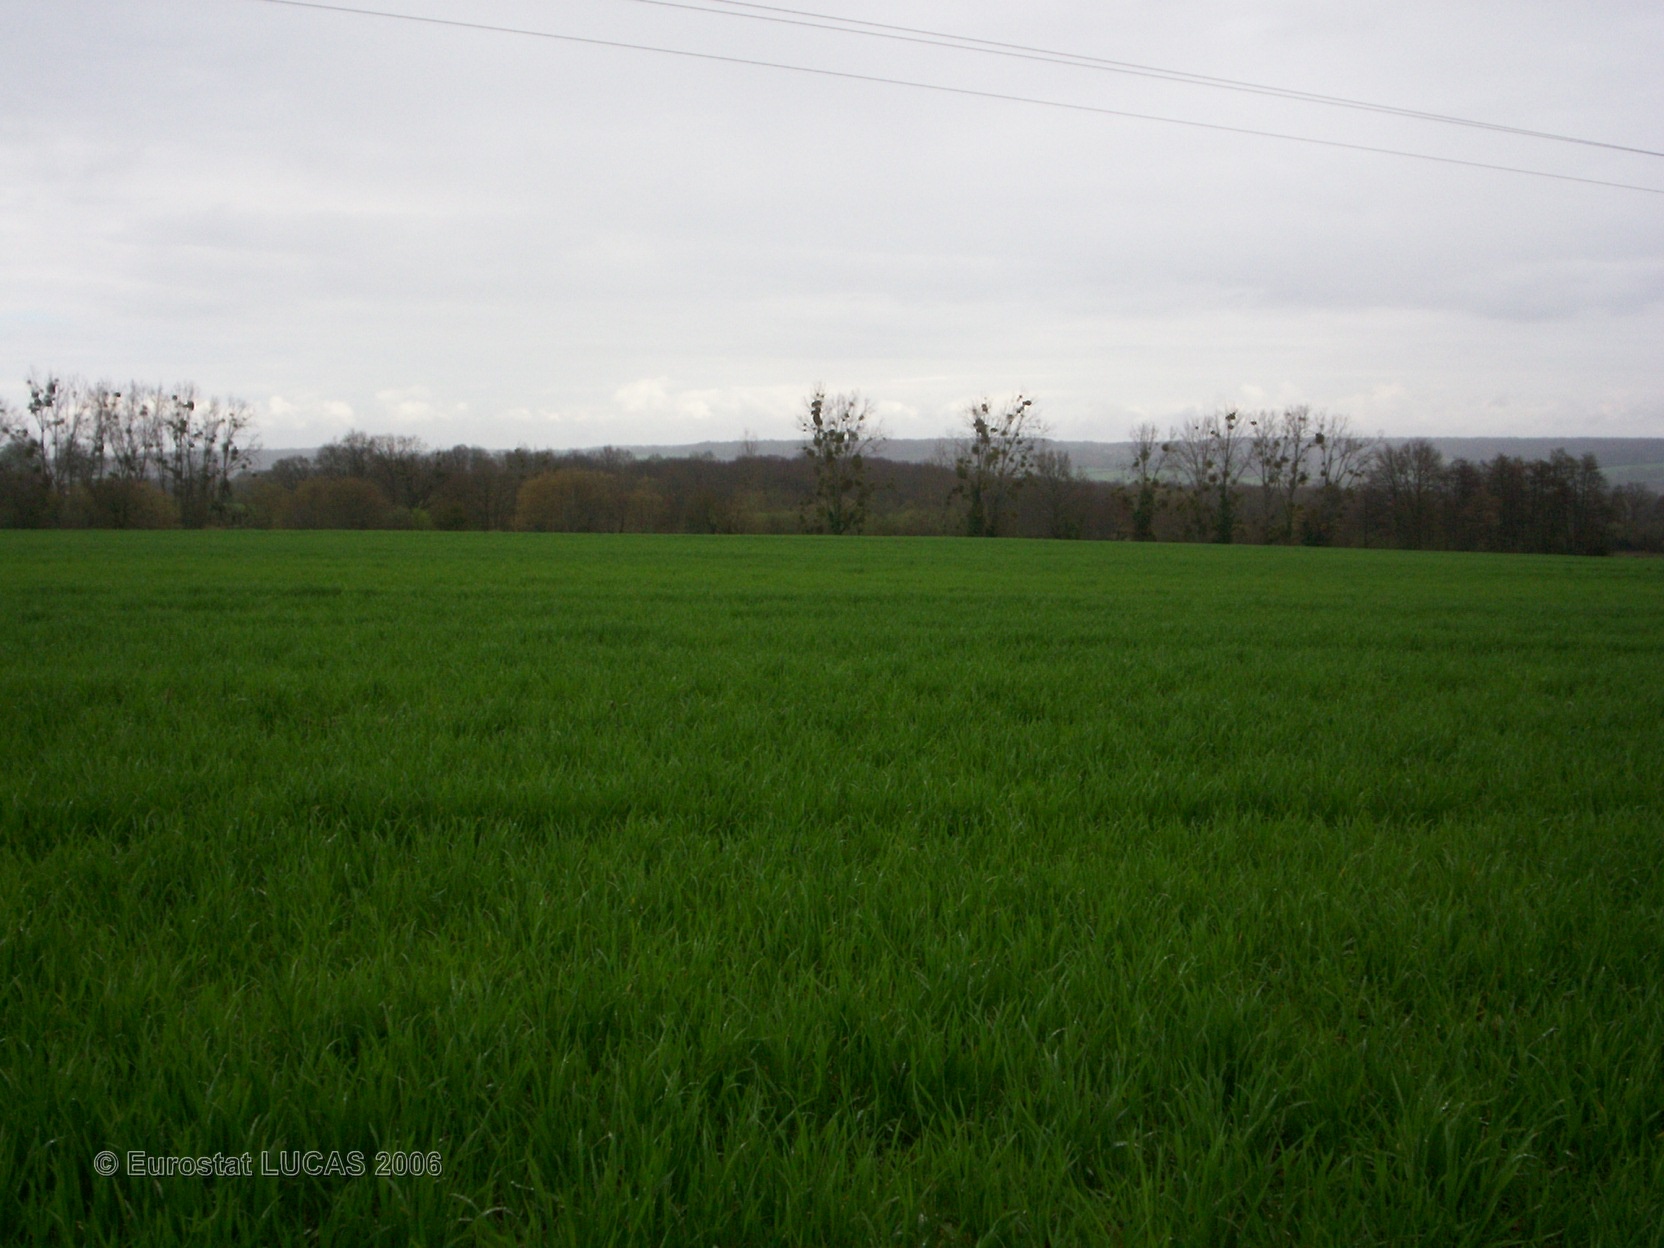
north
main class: Cropland
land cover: Barley
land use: Agriculture (excluding fallow land and kitchen gardens)
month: April
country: FR
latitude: 47.5147
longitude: 3.0229
